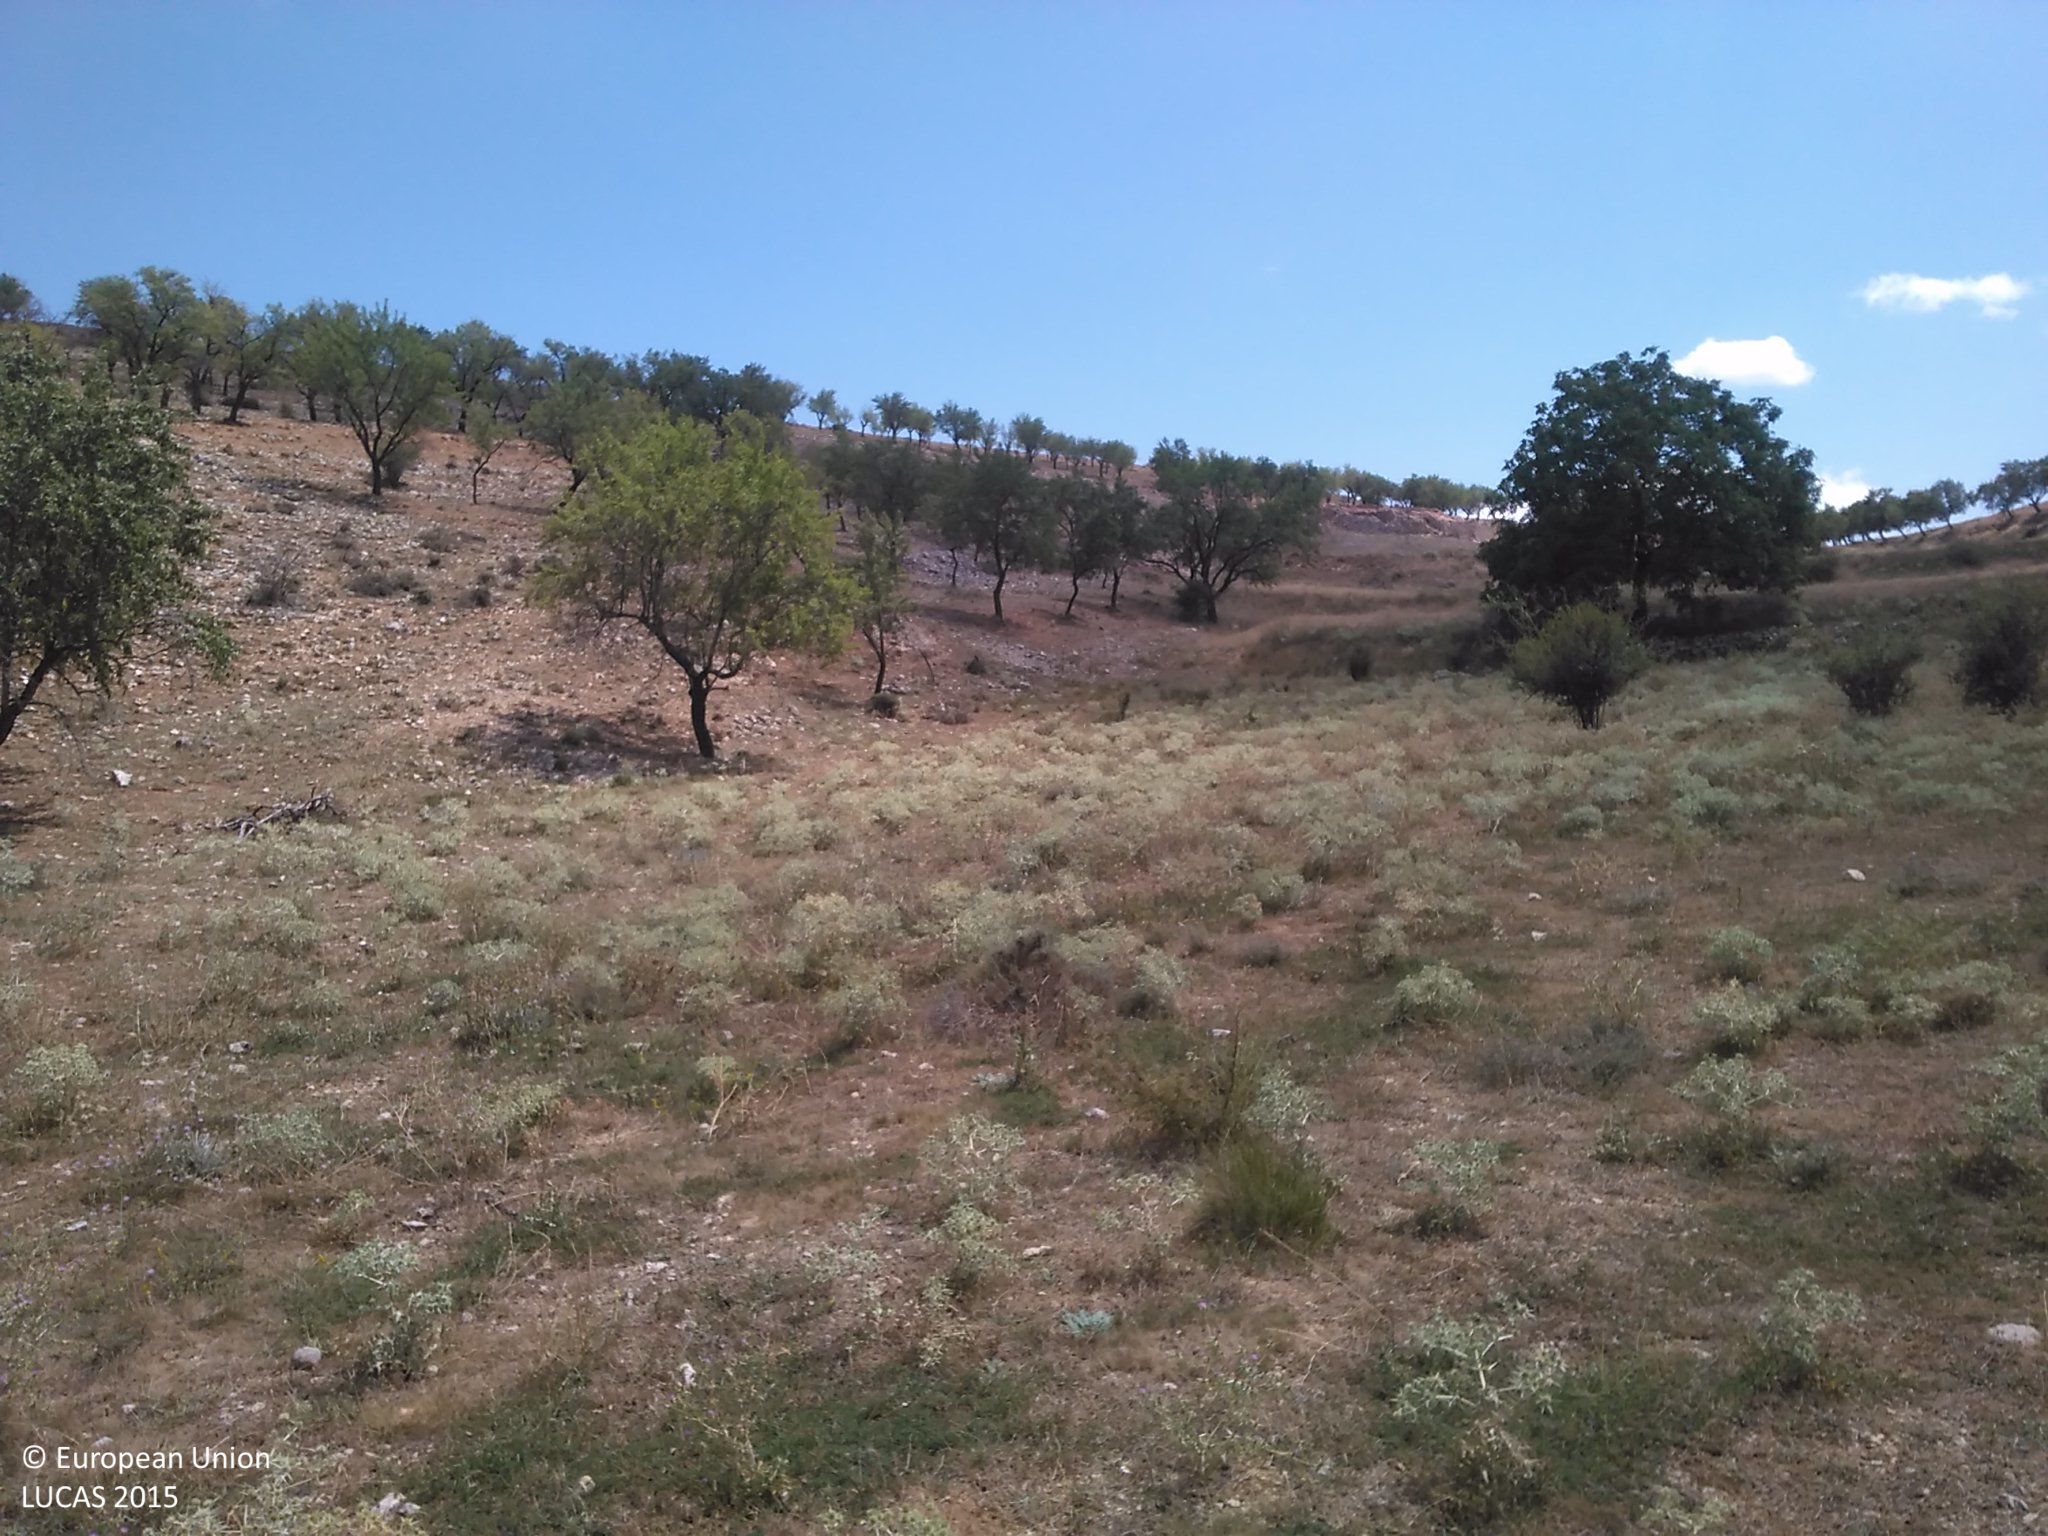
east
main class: Grassland
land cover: Grassland without tree/shrub cover
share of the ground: 50 - 75 %
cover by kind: herbaceous plants 70 %, unconsolidated bare surface 25 %, shrubs 5 %
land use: Agriculture (excluding fallow land and kitchen gardens)
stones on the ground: < 10 %
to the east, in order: Grassland without tree/shrub cover; Nuts trees; Grassland without tree/shrub cover; Tracks; Nuts trees; Shrubland without tree cover
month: July
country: ES
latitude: 41.5623
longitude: -1.9372
